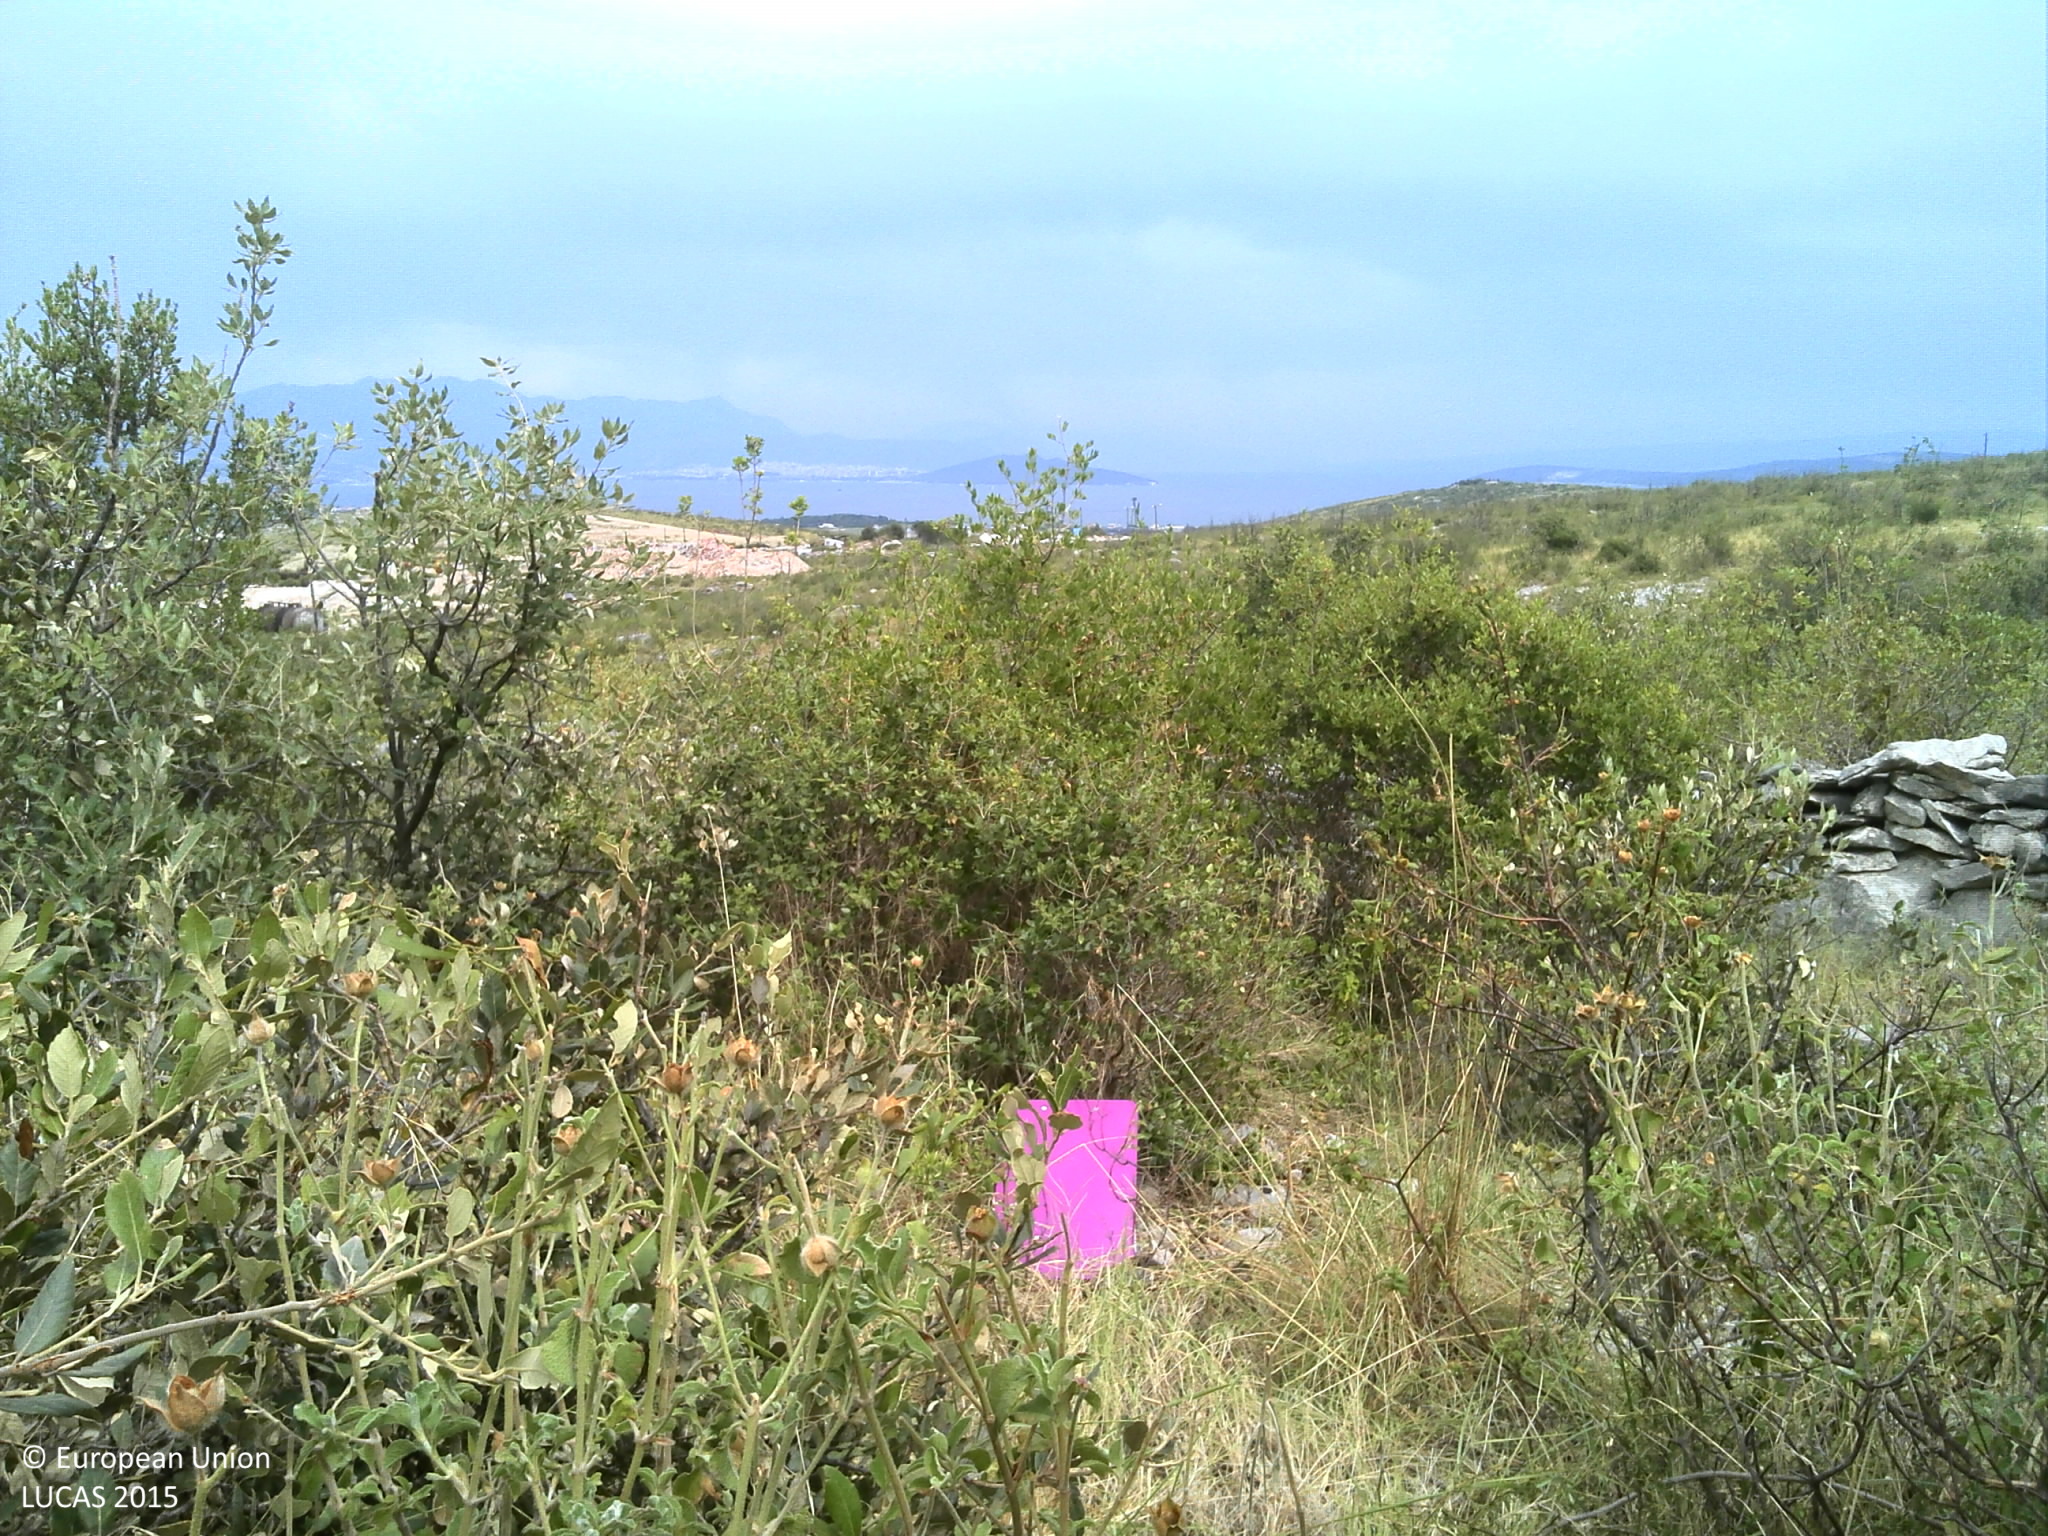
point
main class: Shrubland
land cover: Shrubland without tree cover
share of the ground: 50 - 75 %
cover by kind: shrubs 50 %, herbaceous plants 20 %, consolidated bare surface 15 %, unconsolidated bare surface 15 %
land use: Semi-natural and natural areas not in use
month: June
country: HR
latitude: 43.5461
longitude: 16.2658
